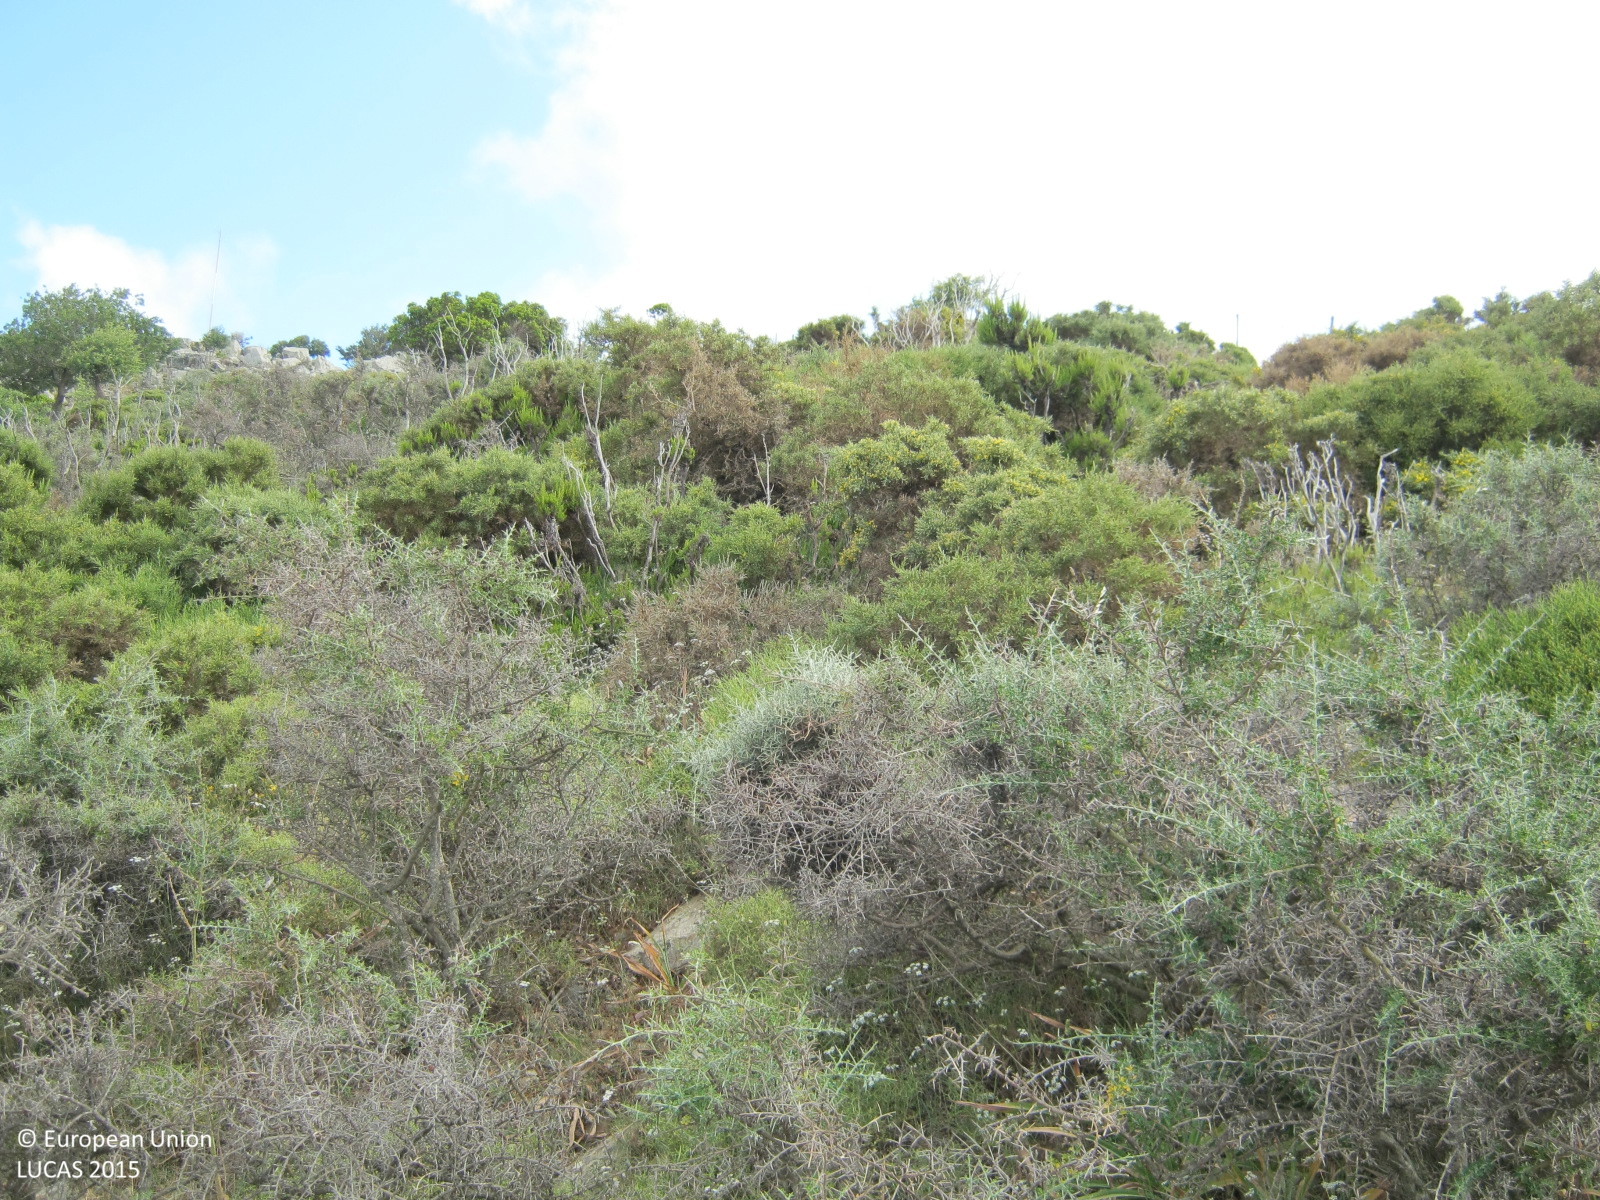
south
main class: Shrubland
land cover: Shrubland with sparse tree cover
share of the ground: > 75 %
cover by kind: shrubs 70 %, unconsolidated bare surface 15 %, herbaceous plants 10 %, broadleaved forest trees 5 %
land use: Agriculture (excluding fallow land and kitchen gardens)
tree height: < 5 m
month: June
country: GR
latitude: 35.3111
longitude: 23.7393
